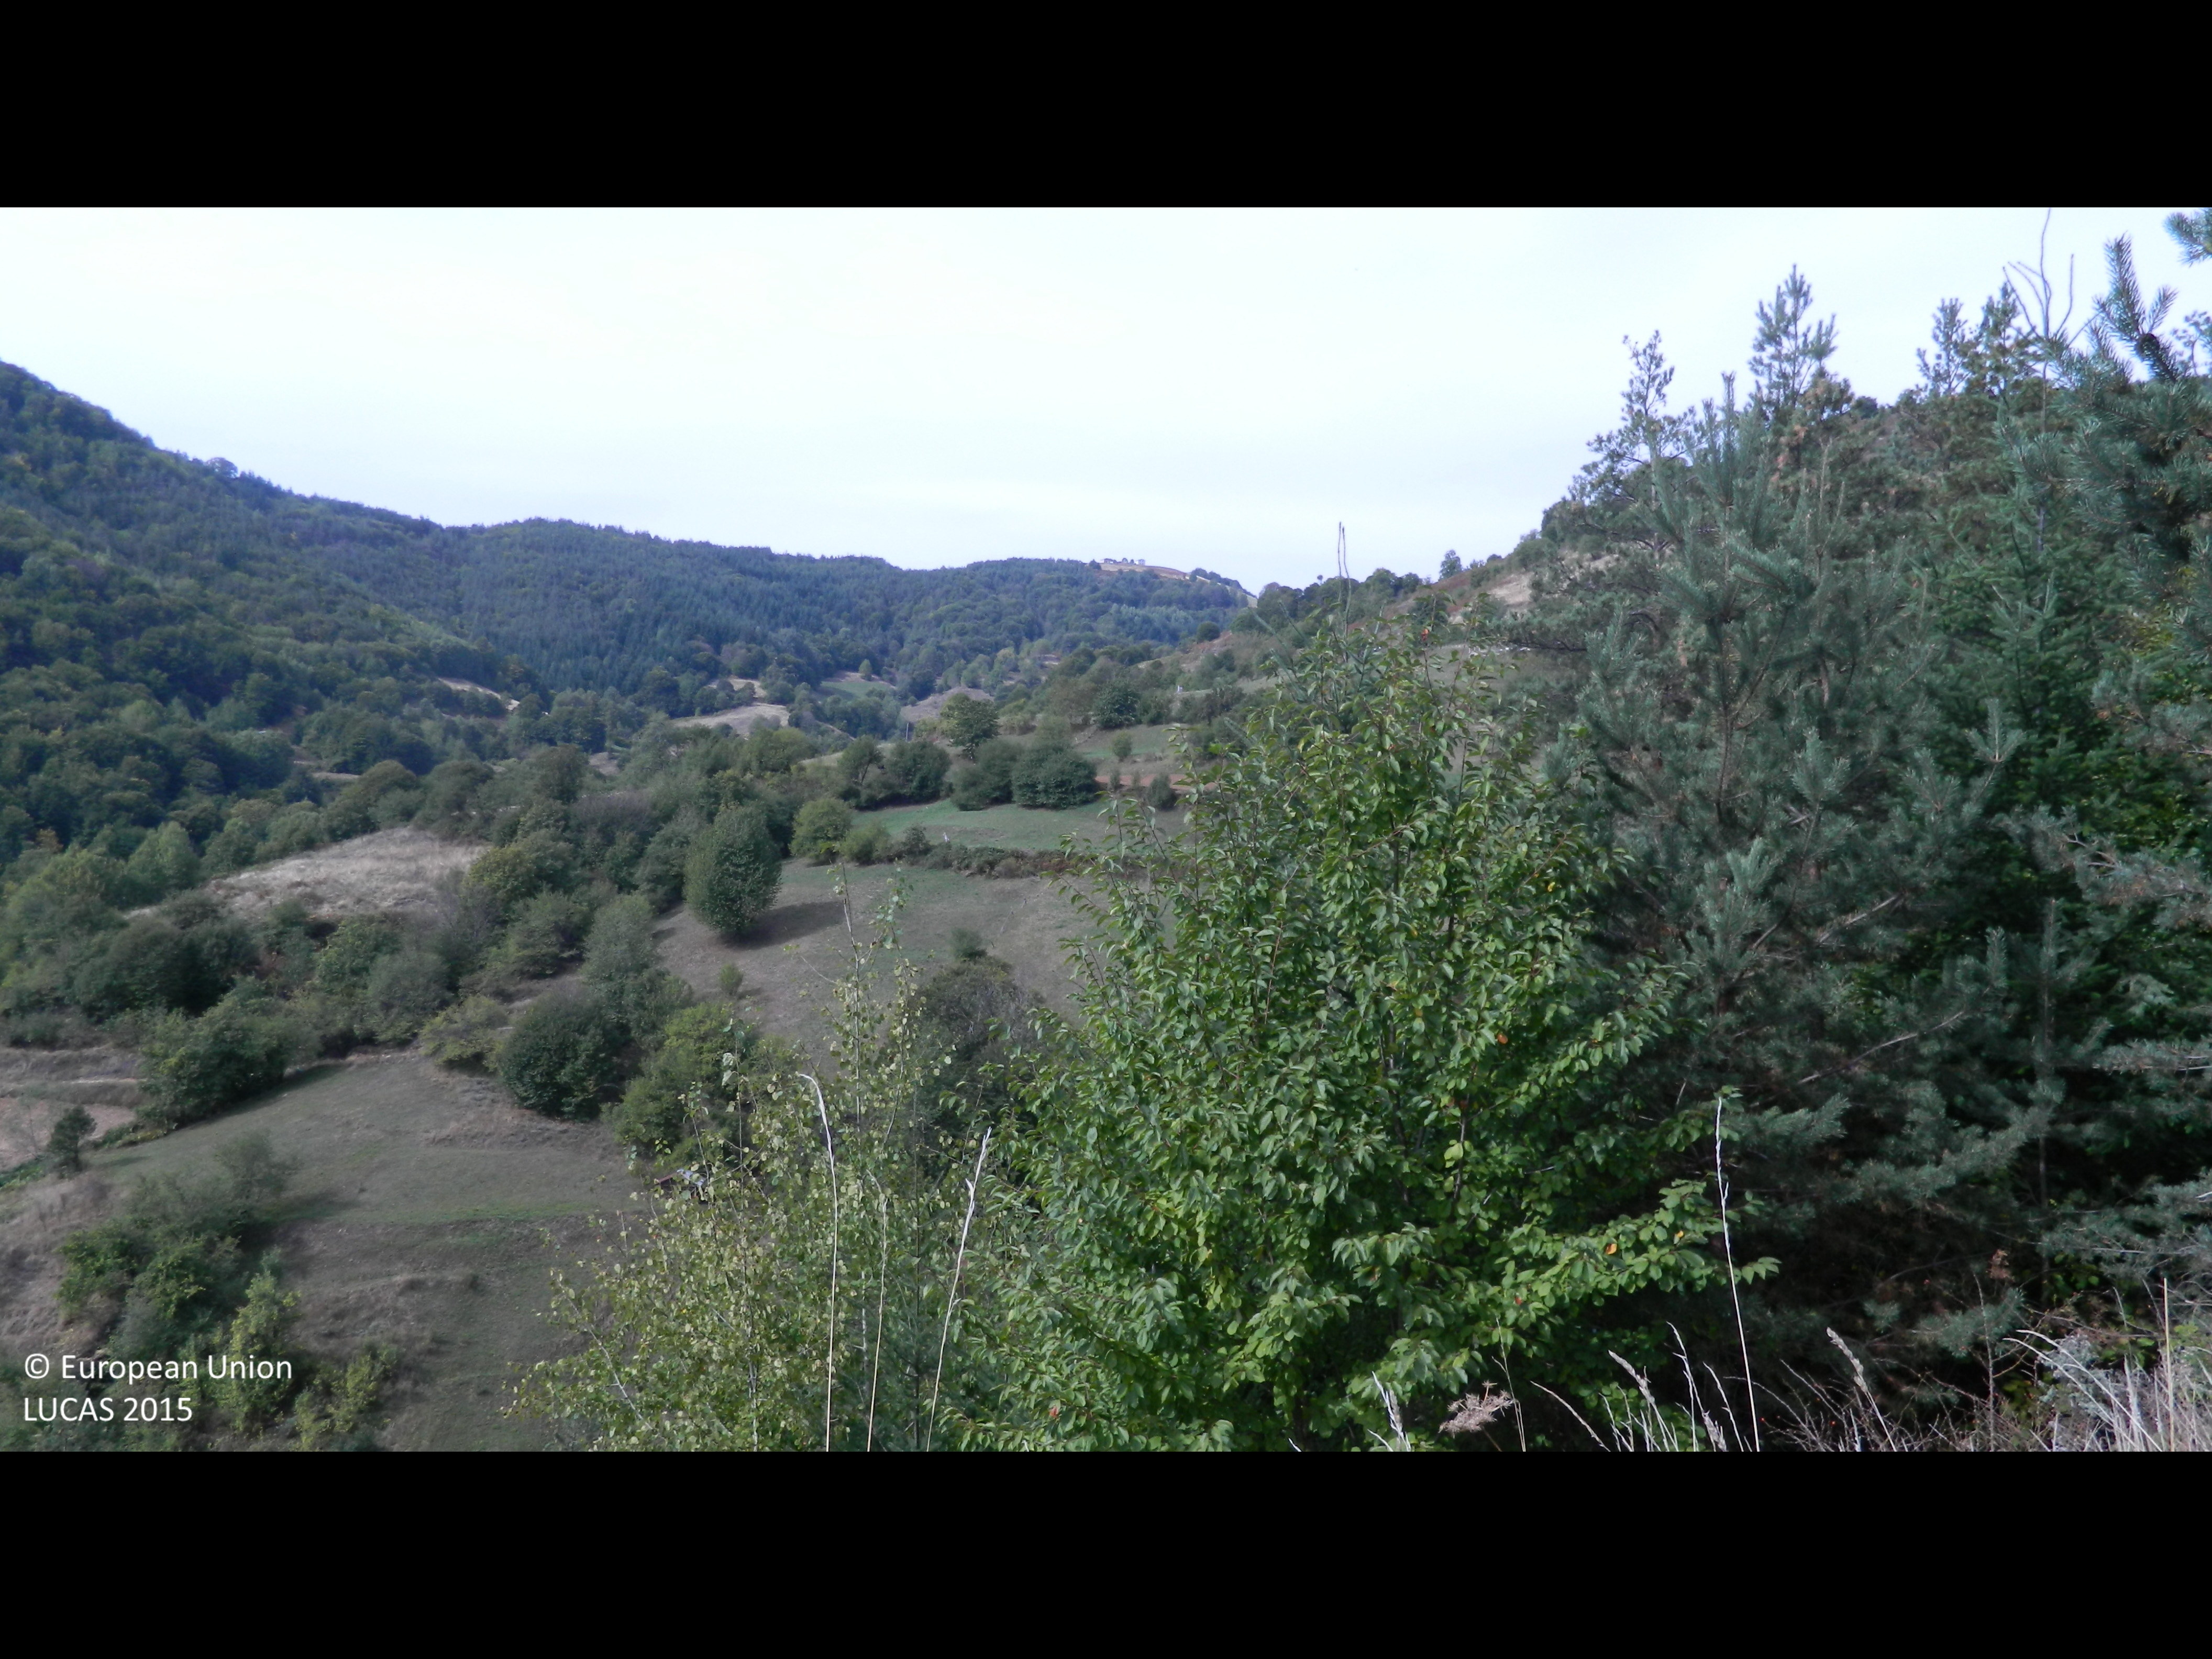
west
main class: Woodland
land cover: Pine dominated mixed woodland
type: hemiboreal forest and nemoral coniferous forest and mixed broadleaved-coniferous forest
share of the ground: > 75 %
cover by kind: coniferous forest trees 75 %, broadleaved forest trees 25 %
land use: Forestry
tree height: > 5 m
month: October
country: BG
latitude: 41.5838
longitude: 24.8848
